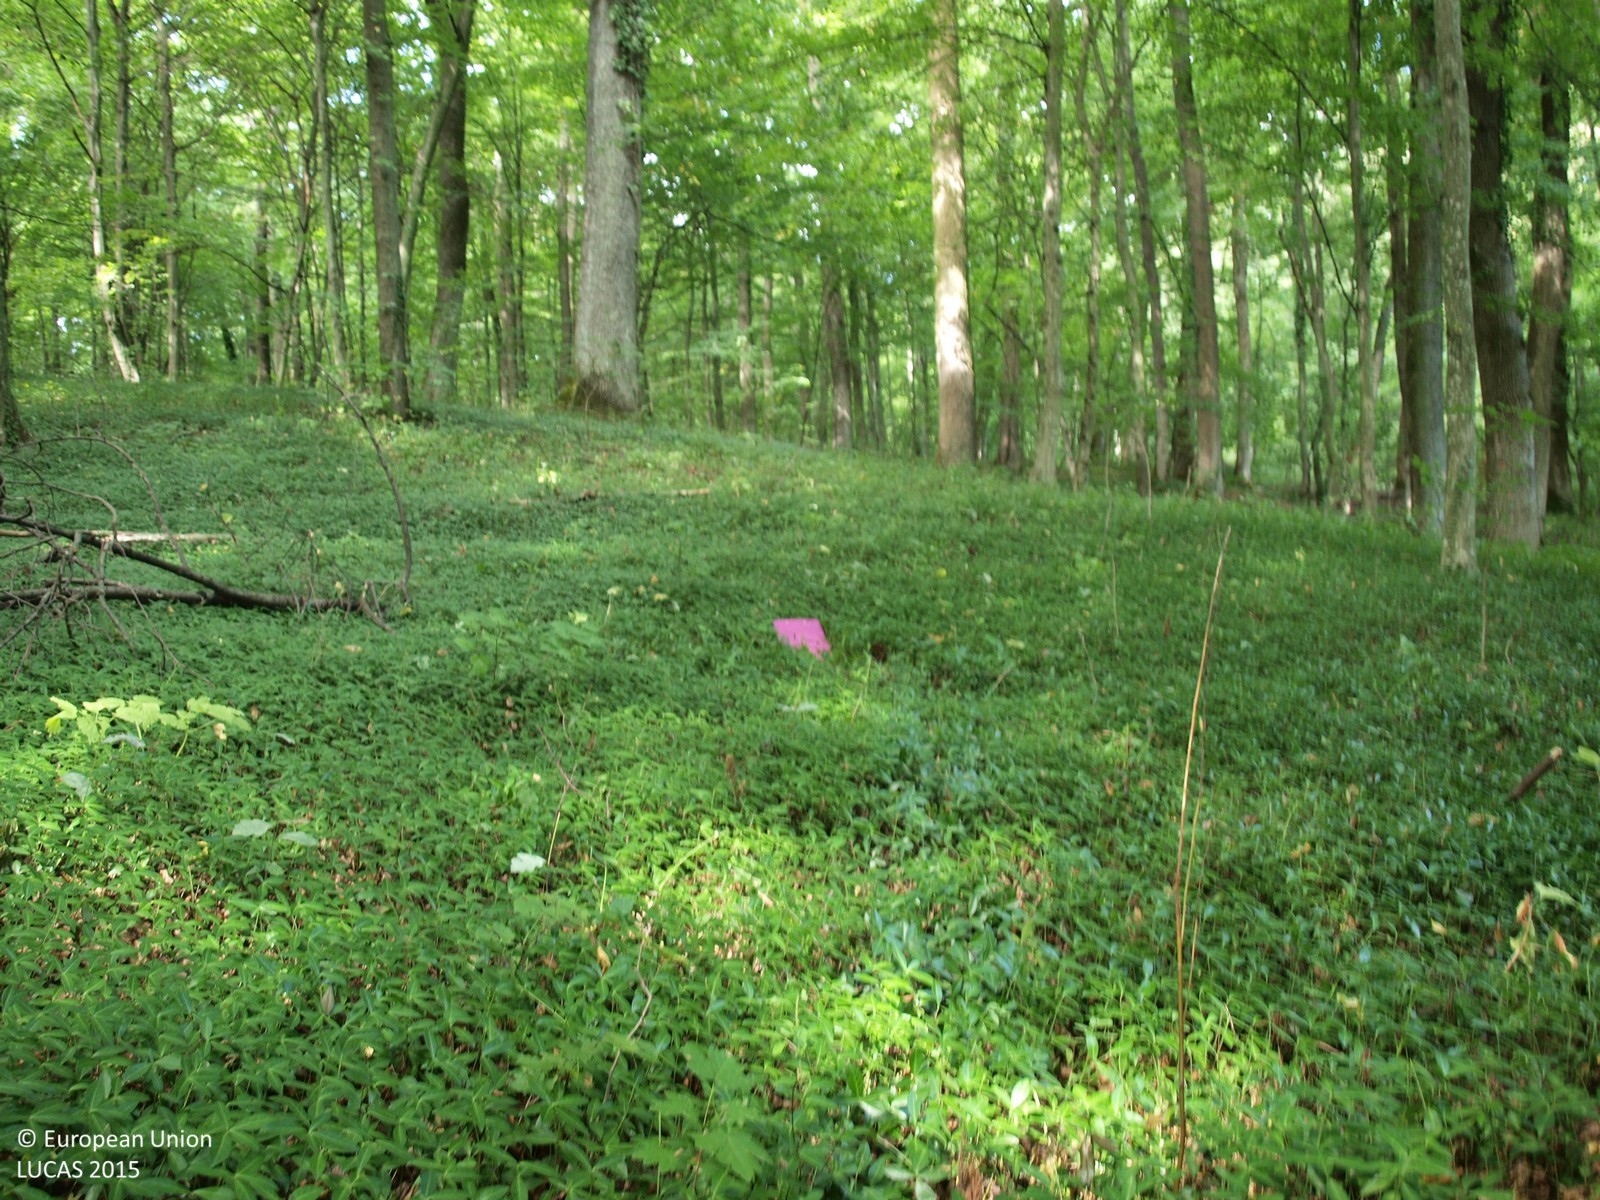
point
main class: Woodland
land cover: Broadleaved woodland
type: mesophytic deciduous forest
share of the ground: > 75 %
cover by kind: broadleaved forest trees 100 %
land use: Forestry
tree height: > 5 m
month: August
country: HR
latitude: 46.0224
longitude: 16.5751
